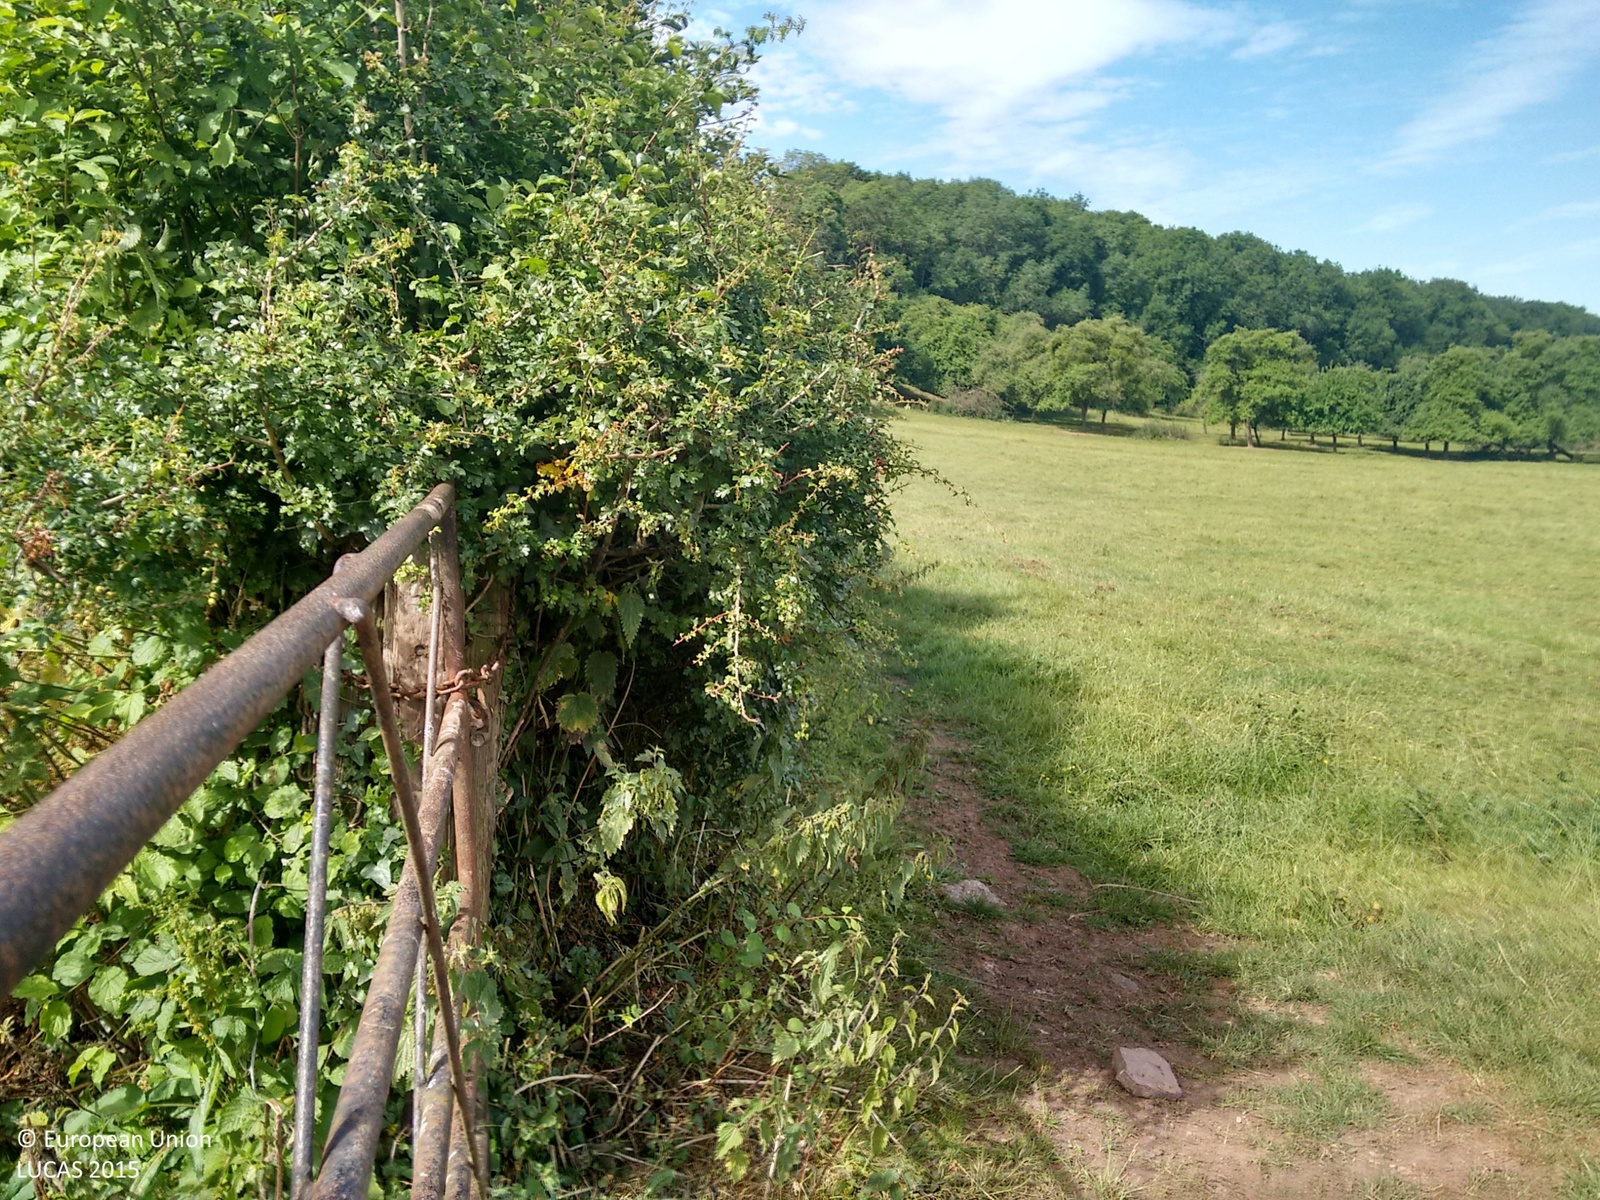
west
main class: Grassland
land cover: Grassland without tree/shrub cover
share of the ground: > 75 %
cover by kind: herbaceous plants 100 %
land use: Agriculture (excluding fallow land and kitchen gardens)
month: July
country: GB
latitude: 52.1491
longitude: -2.6818
